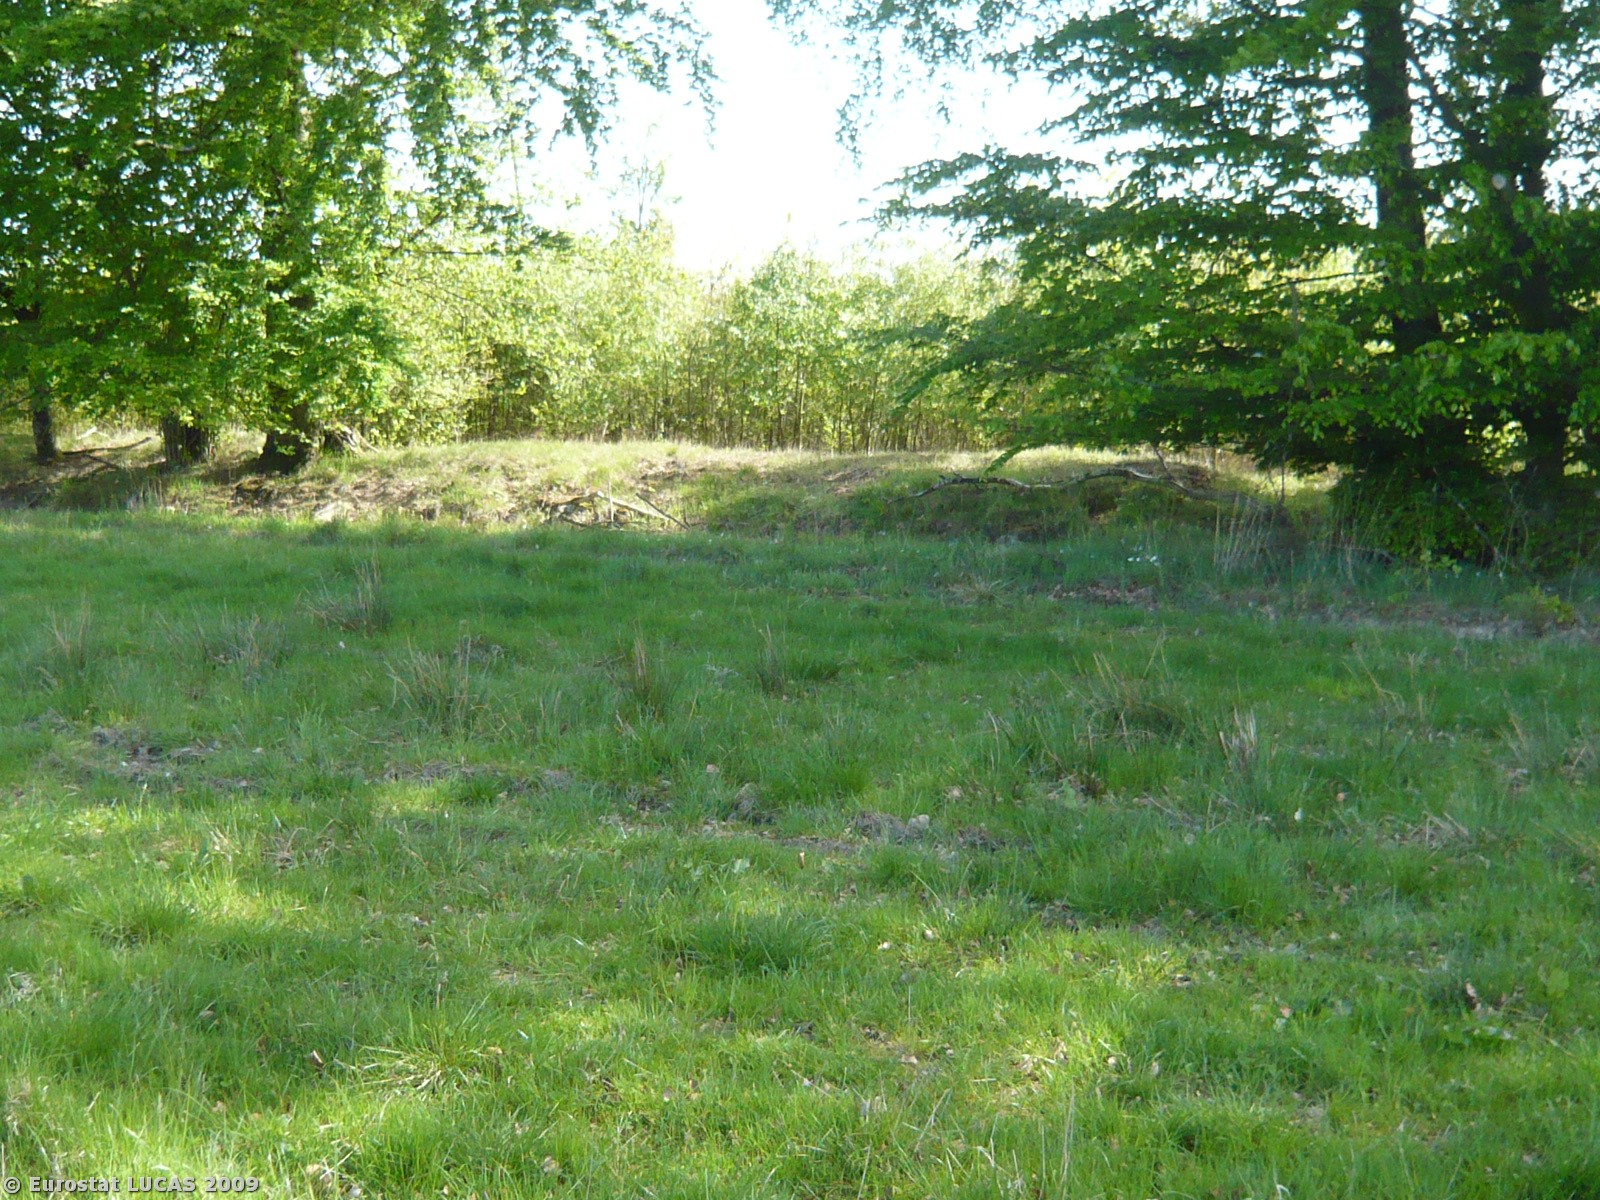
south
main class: Woodland
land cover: Coniferous woodland
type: plantations and self-sown exotic forest
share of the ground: 25 - 50 %
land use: Forestry
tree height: > 5 m
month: May
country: DK
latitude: 55.2557
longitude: 11.9652
